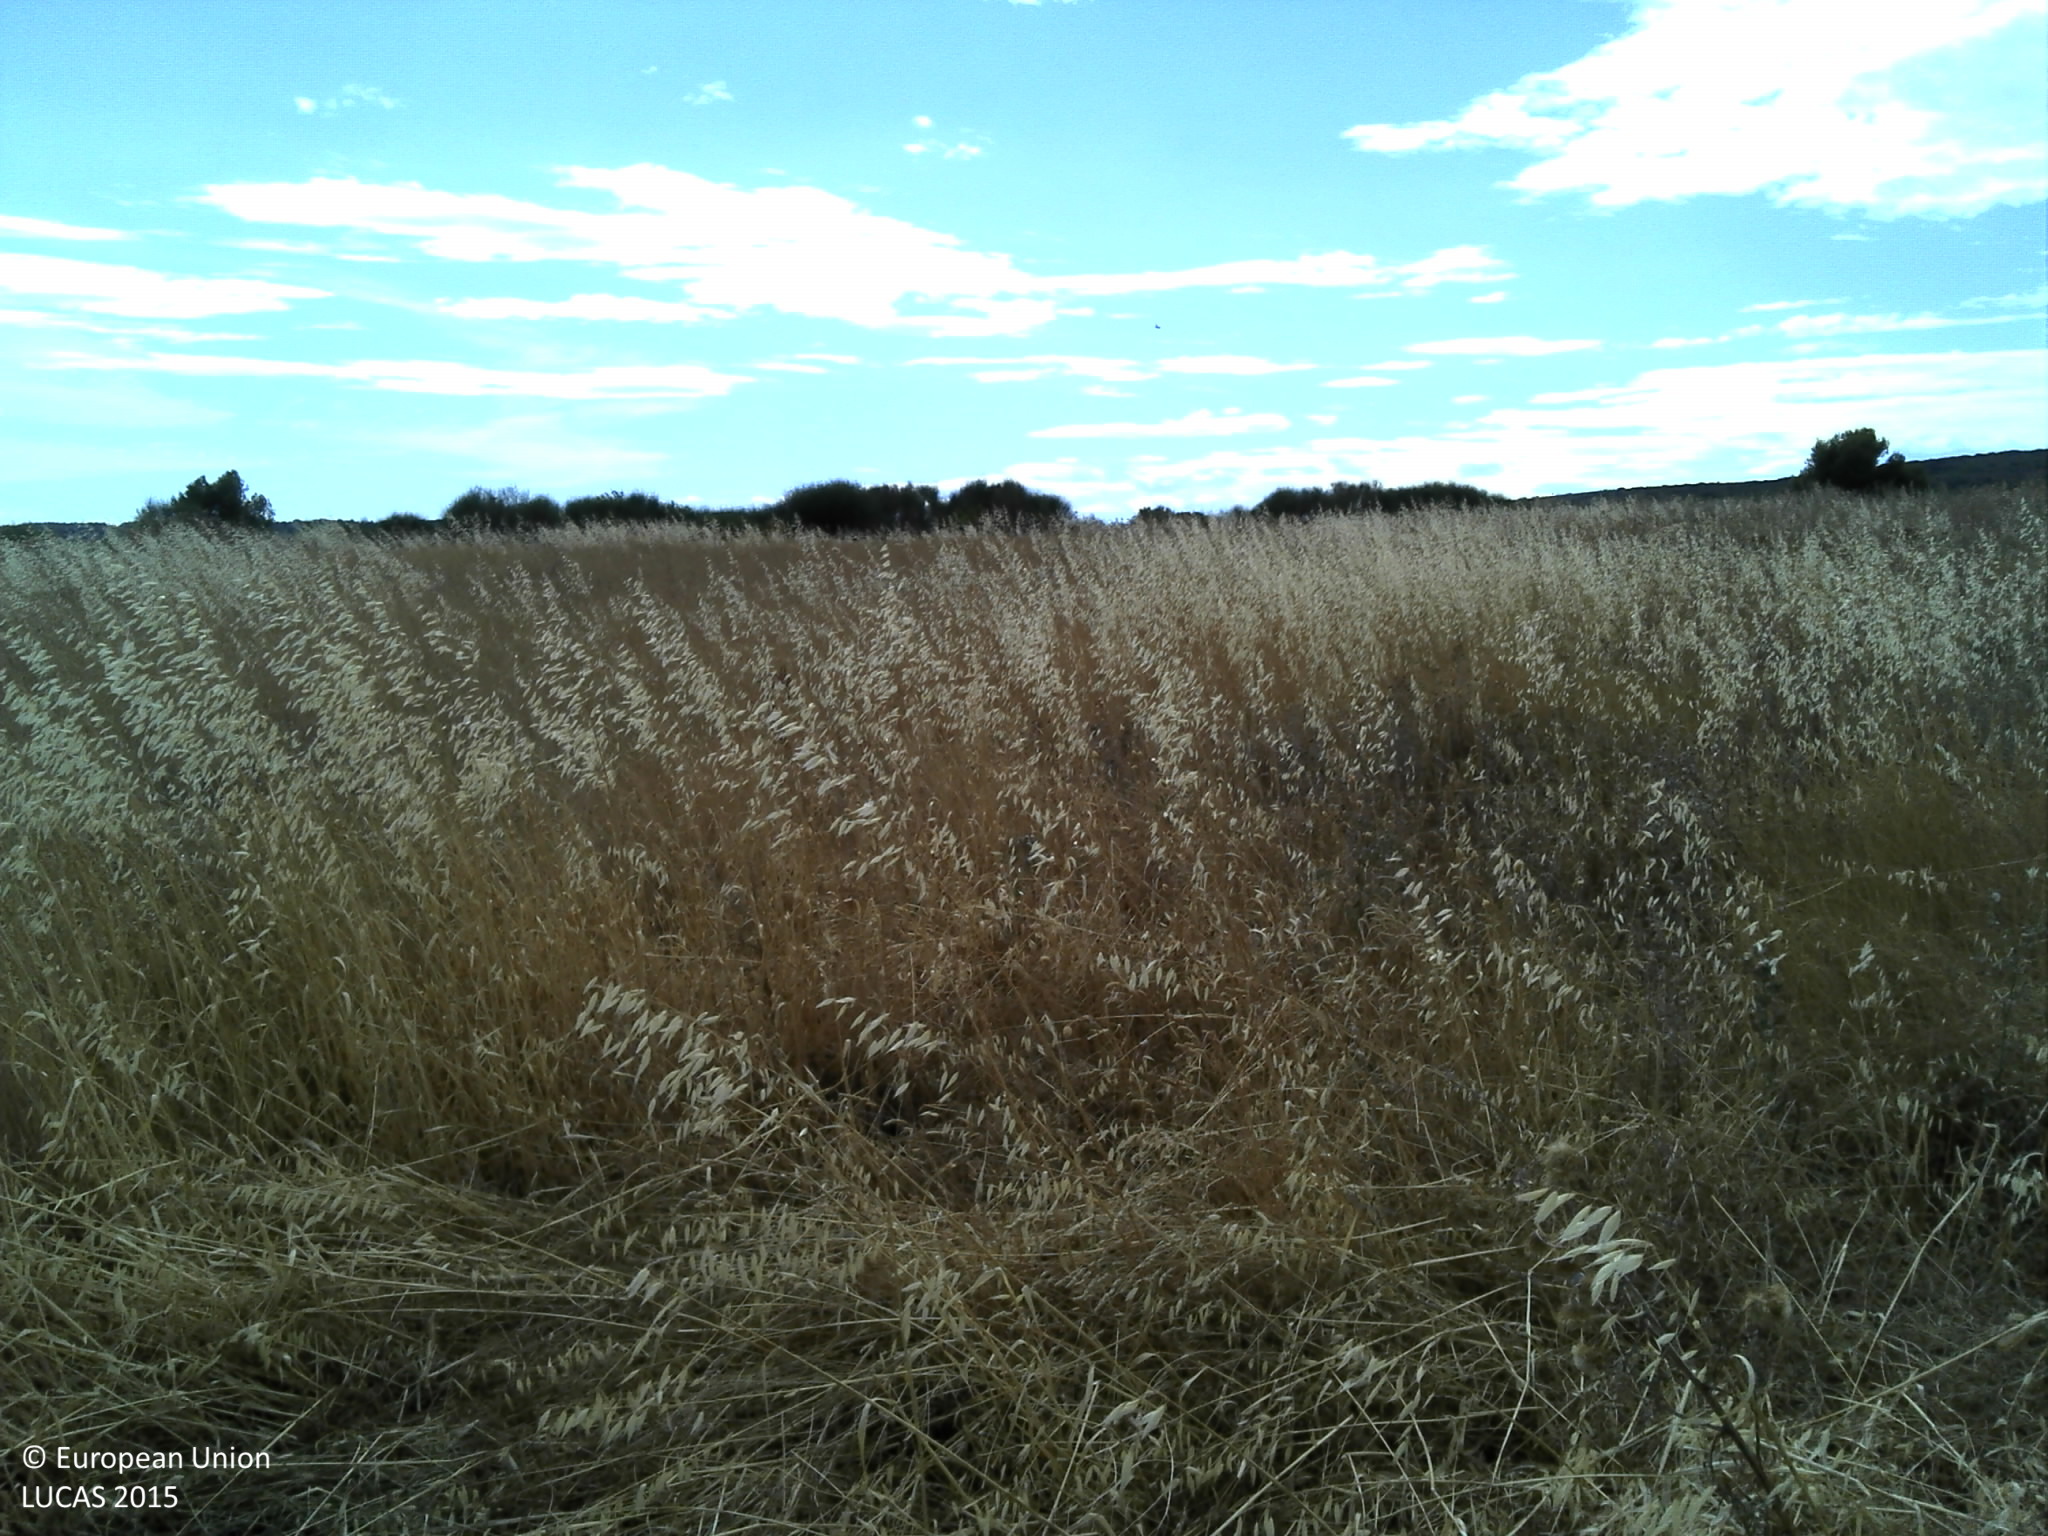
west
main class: Grassland
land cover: Spontaneously vegetated surfaces
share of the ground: > 75 %
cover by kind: herbaceous plants 100 %
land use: Fallow land
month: July
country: FR
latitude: 43.5190
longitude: 3.5885
